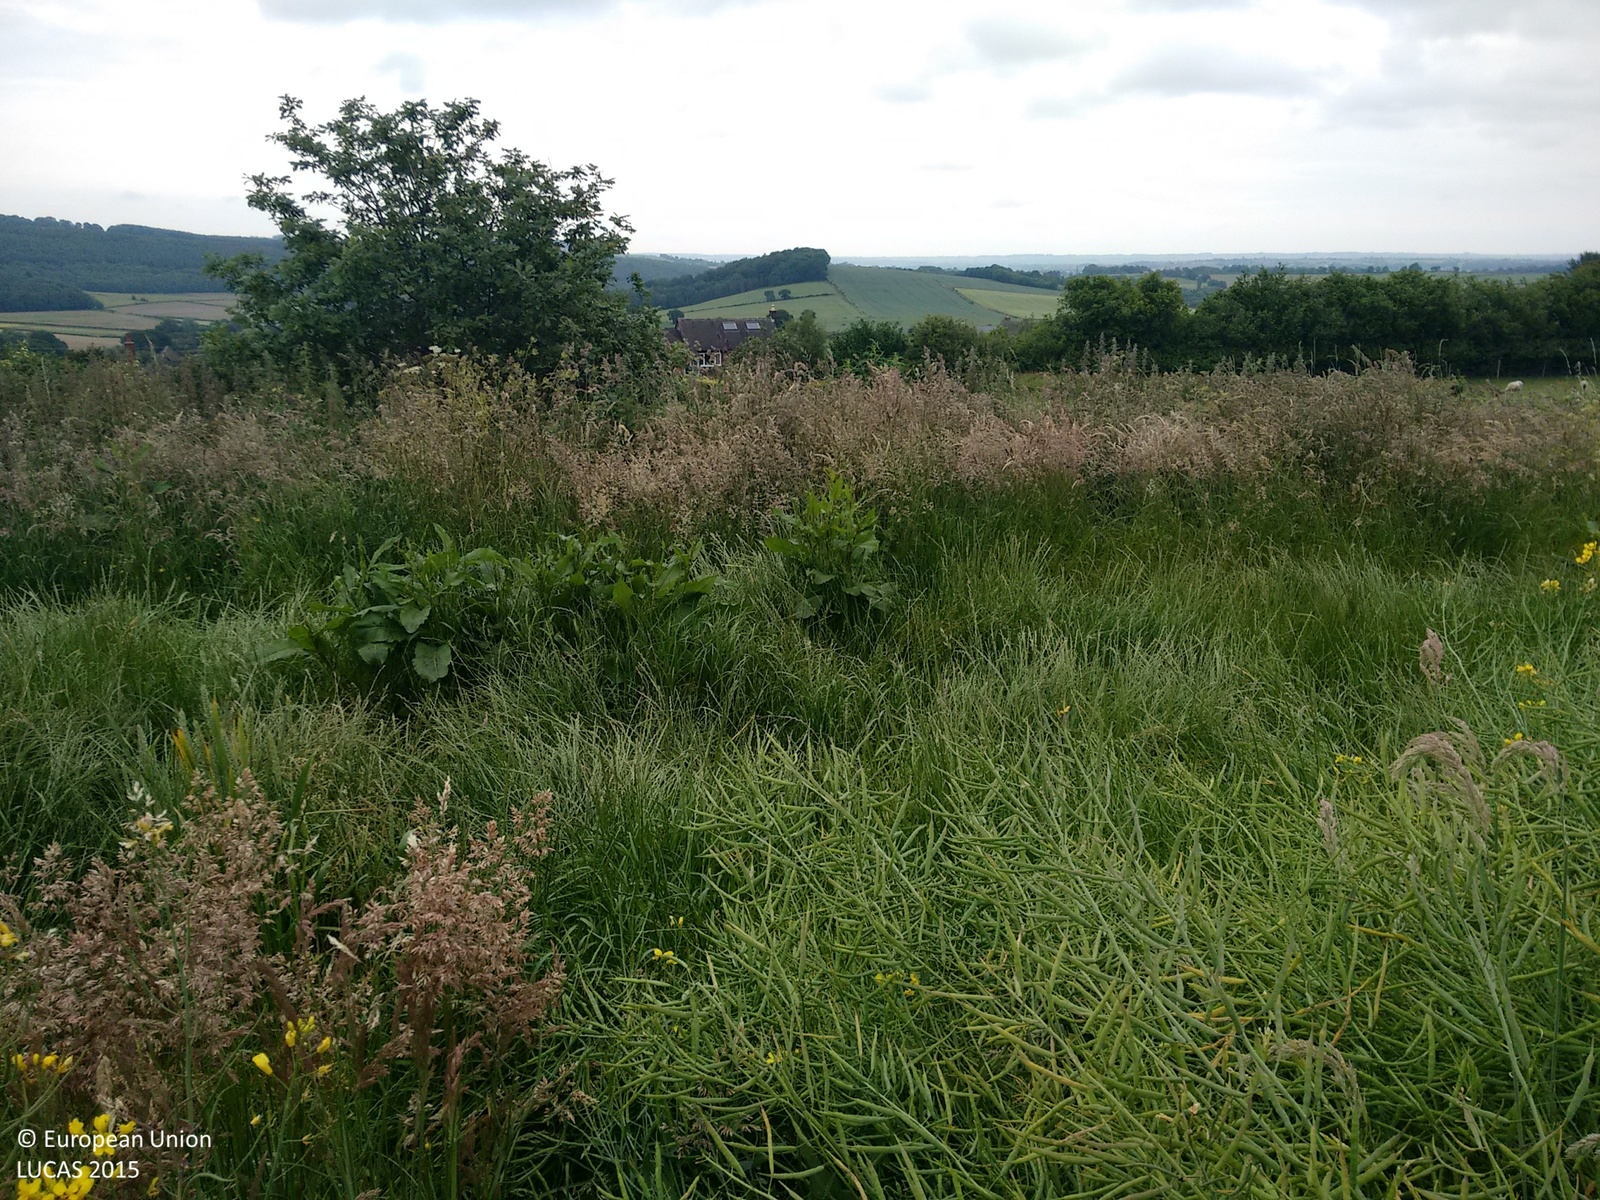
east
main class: Cropland
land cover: Rape and turnip rape
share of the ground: > 75 %
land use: Agriculture (excluding fallow land and kitchen gardens)
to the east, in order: Rape and turnip rape; Tracks; Managed hedges; Grassland without tree/shrub cover; Managed hedges; Grassland without tree/shrub cover
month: June
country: GB
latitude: 53.2707
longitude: -1.4911
